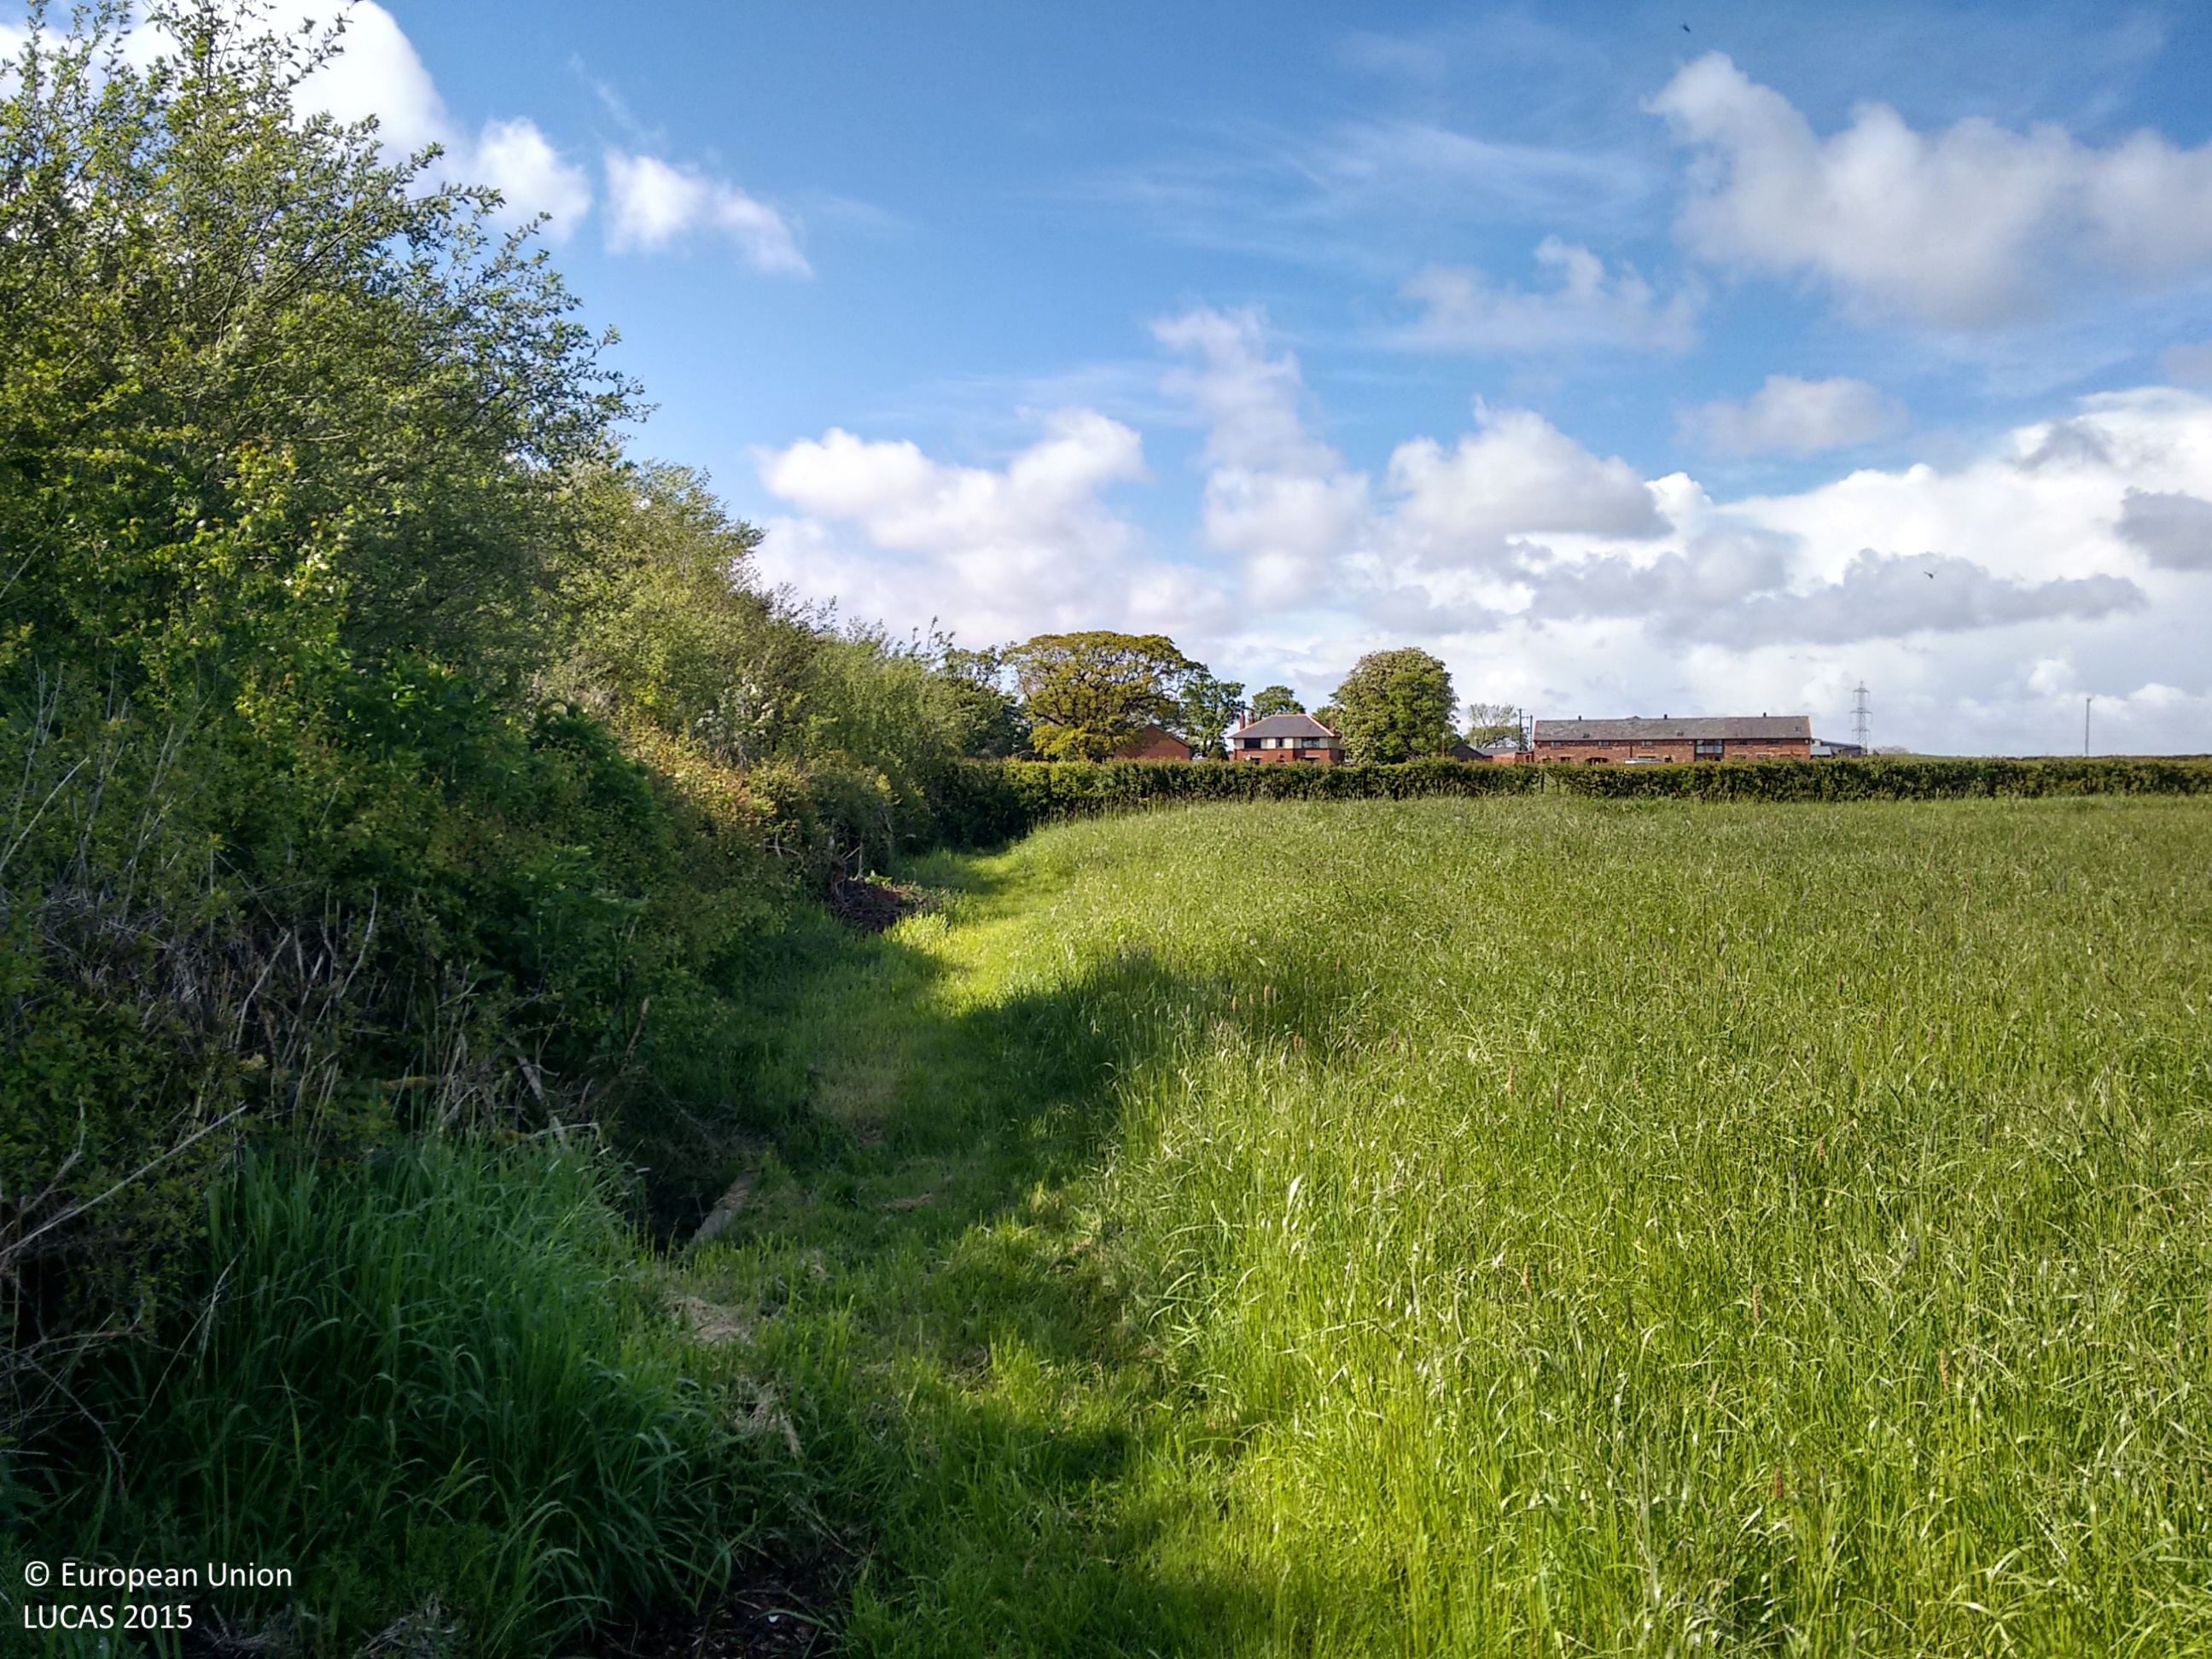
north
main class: Grassland
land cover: Grassland without tree/shrub cover
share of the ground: > 75 %
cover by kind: herbaceous plants 100 %
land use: Construction
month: May
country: GB
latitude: 53.8542
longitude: -2.9183
